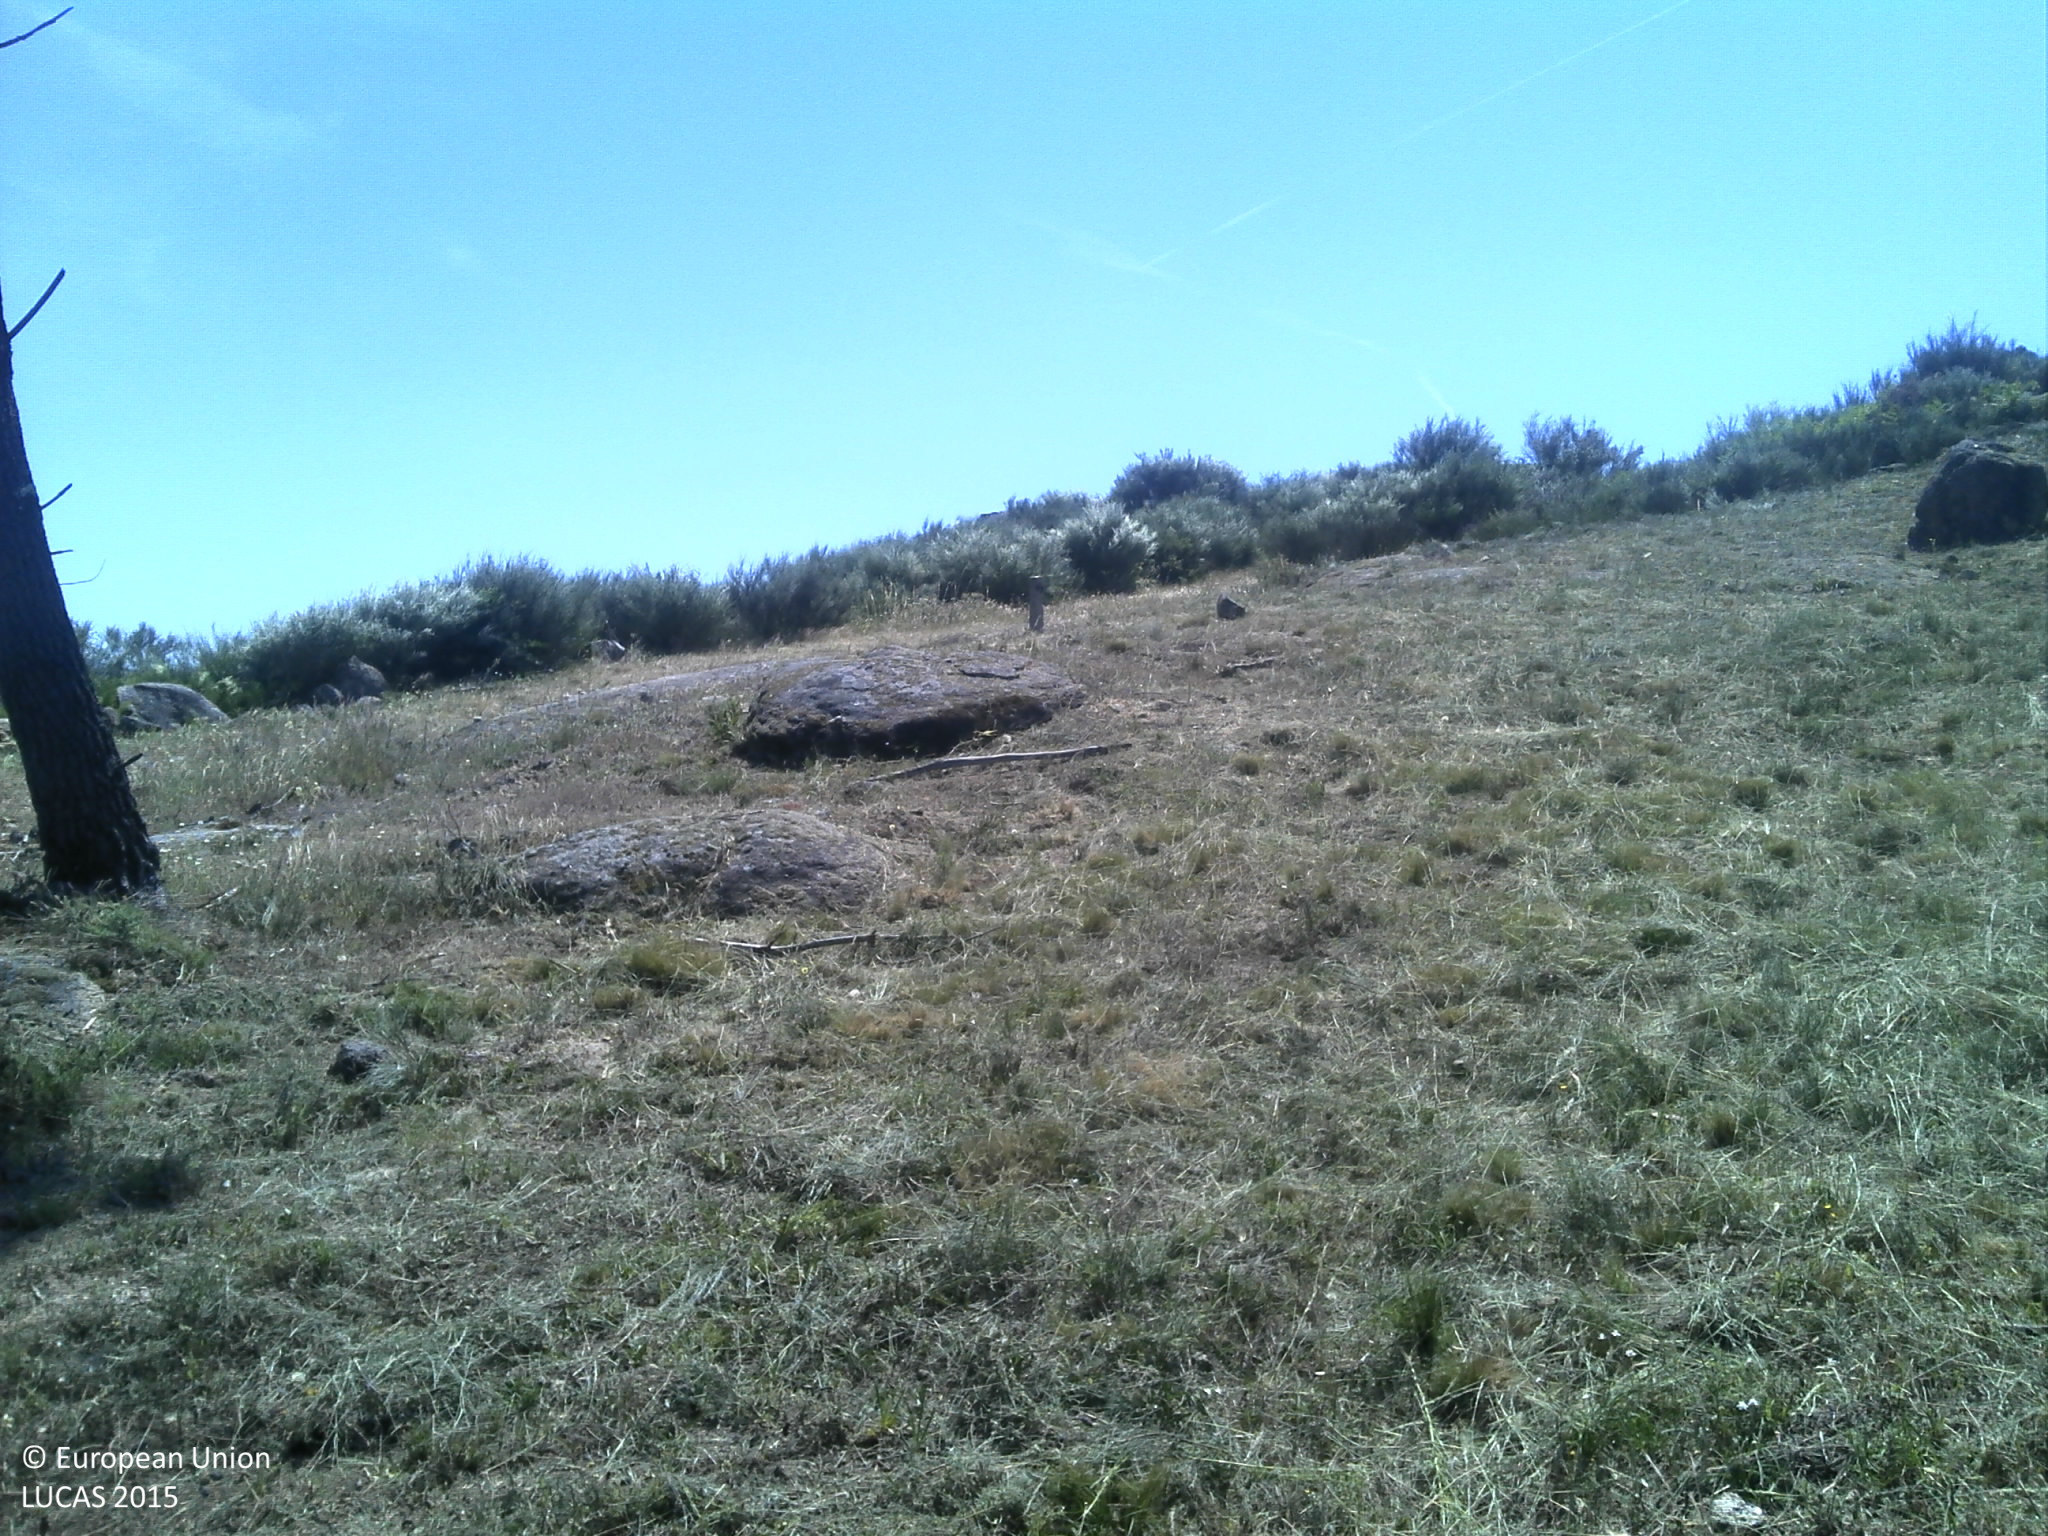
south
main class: Grassland
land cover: Grassland without tree/shrub cover
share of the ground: 50 - 75 %
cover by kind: herbaceous plants 50 %, unconsolidated bare surface 40 %
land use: Agriculture (excluding fallow land and kitchen gardens)
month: May
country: PT
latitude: 40.5021
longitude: -7.7346
